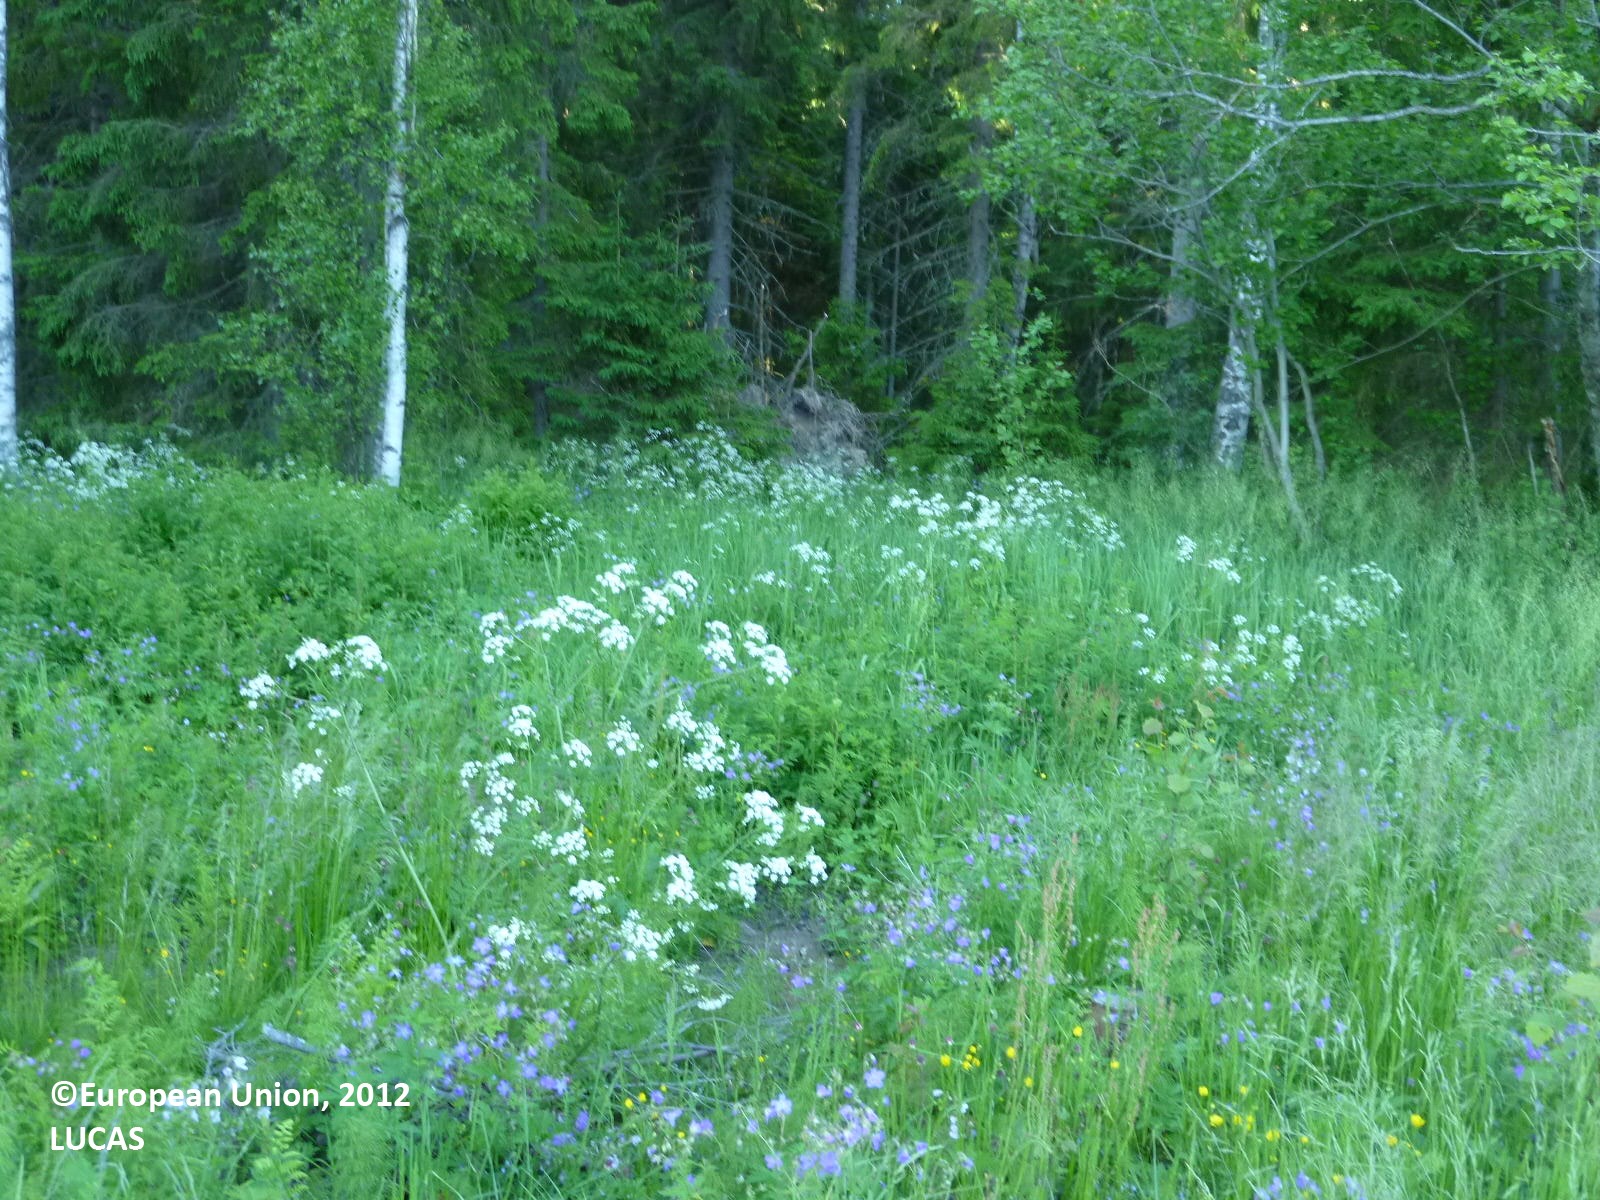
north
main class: Grassland
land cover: Grassland without tree/shrub cover
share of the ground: 25 - 50 %
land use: Forestry
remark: Clear cut
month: June
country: FI
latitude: 61.6666
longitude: 22.0880
